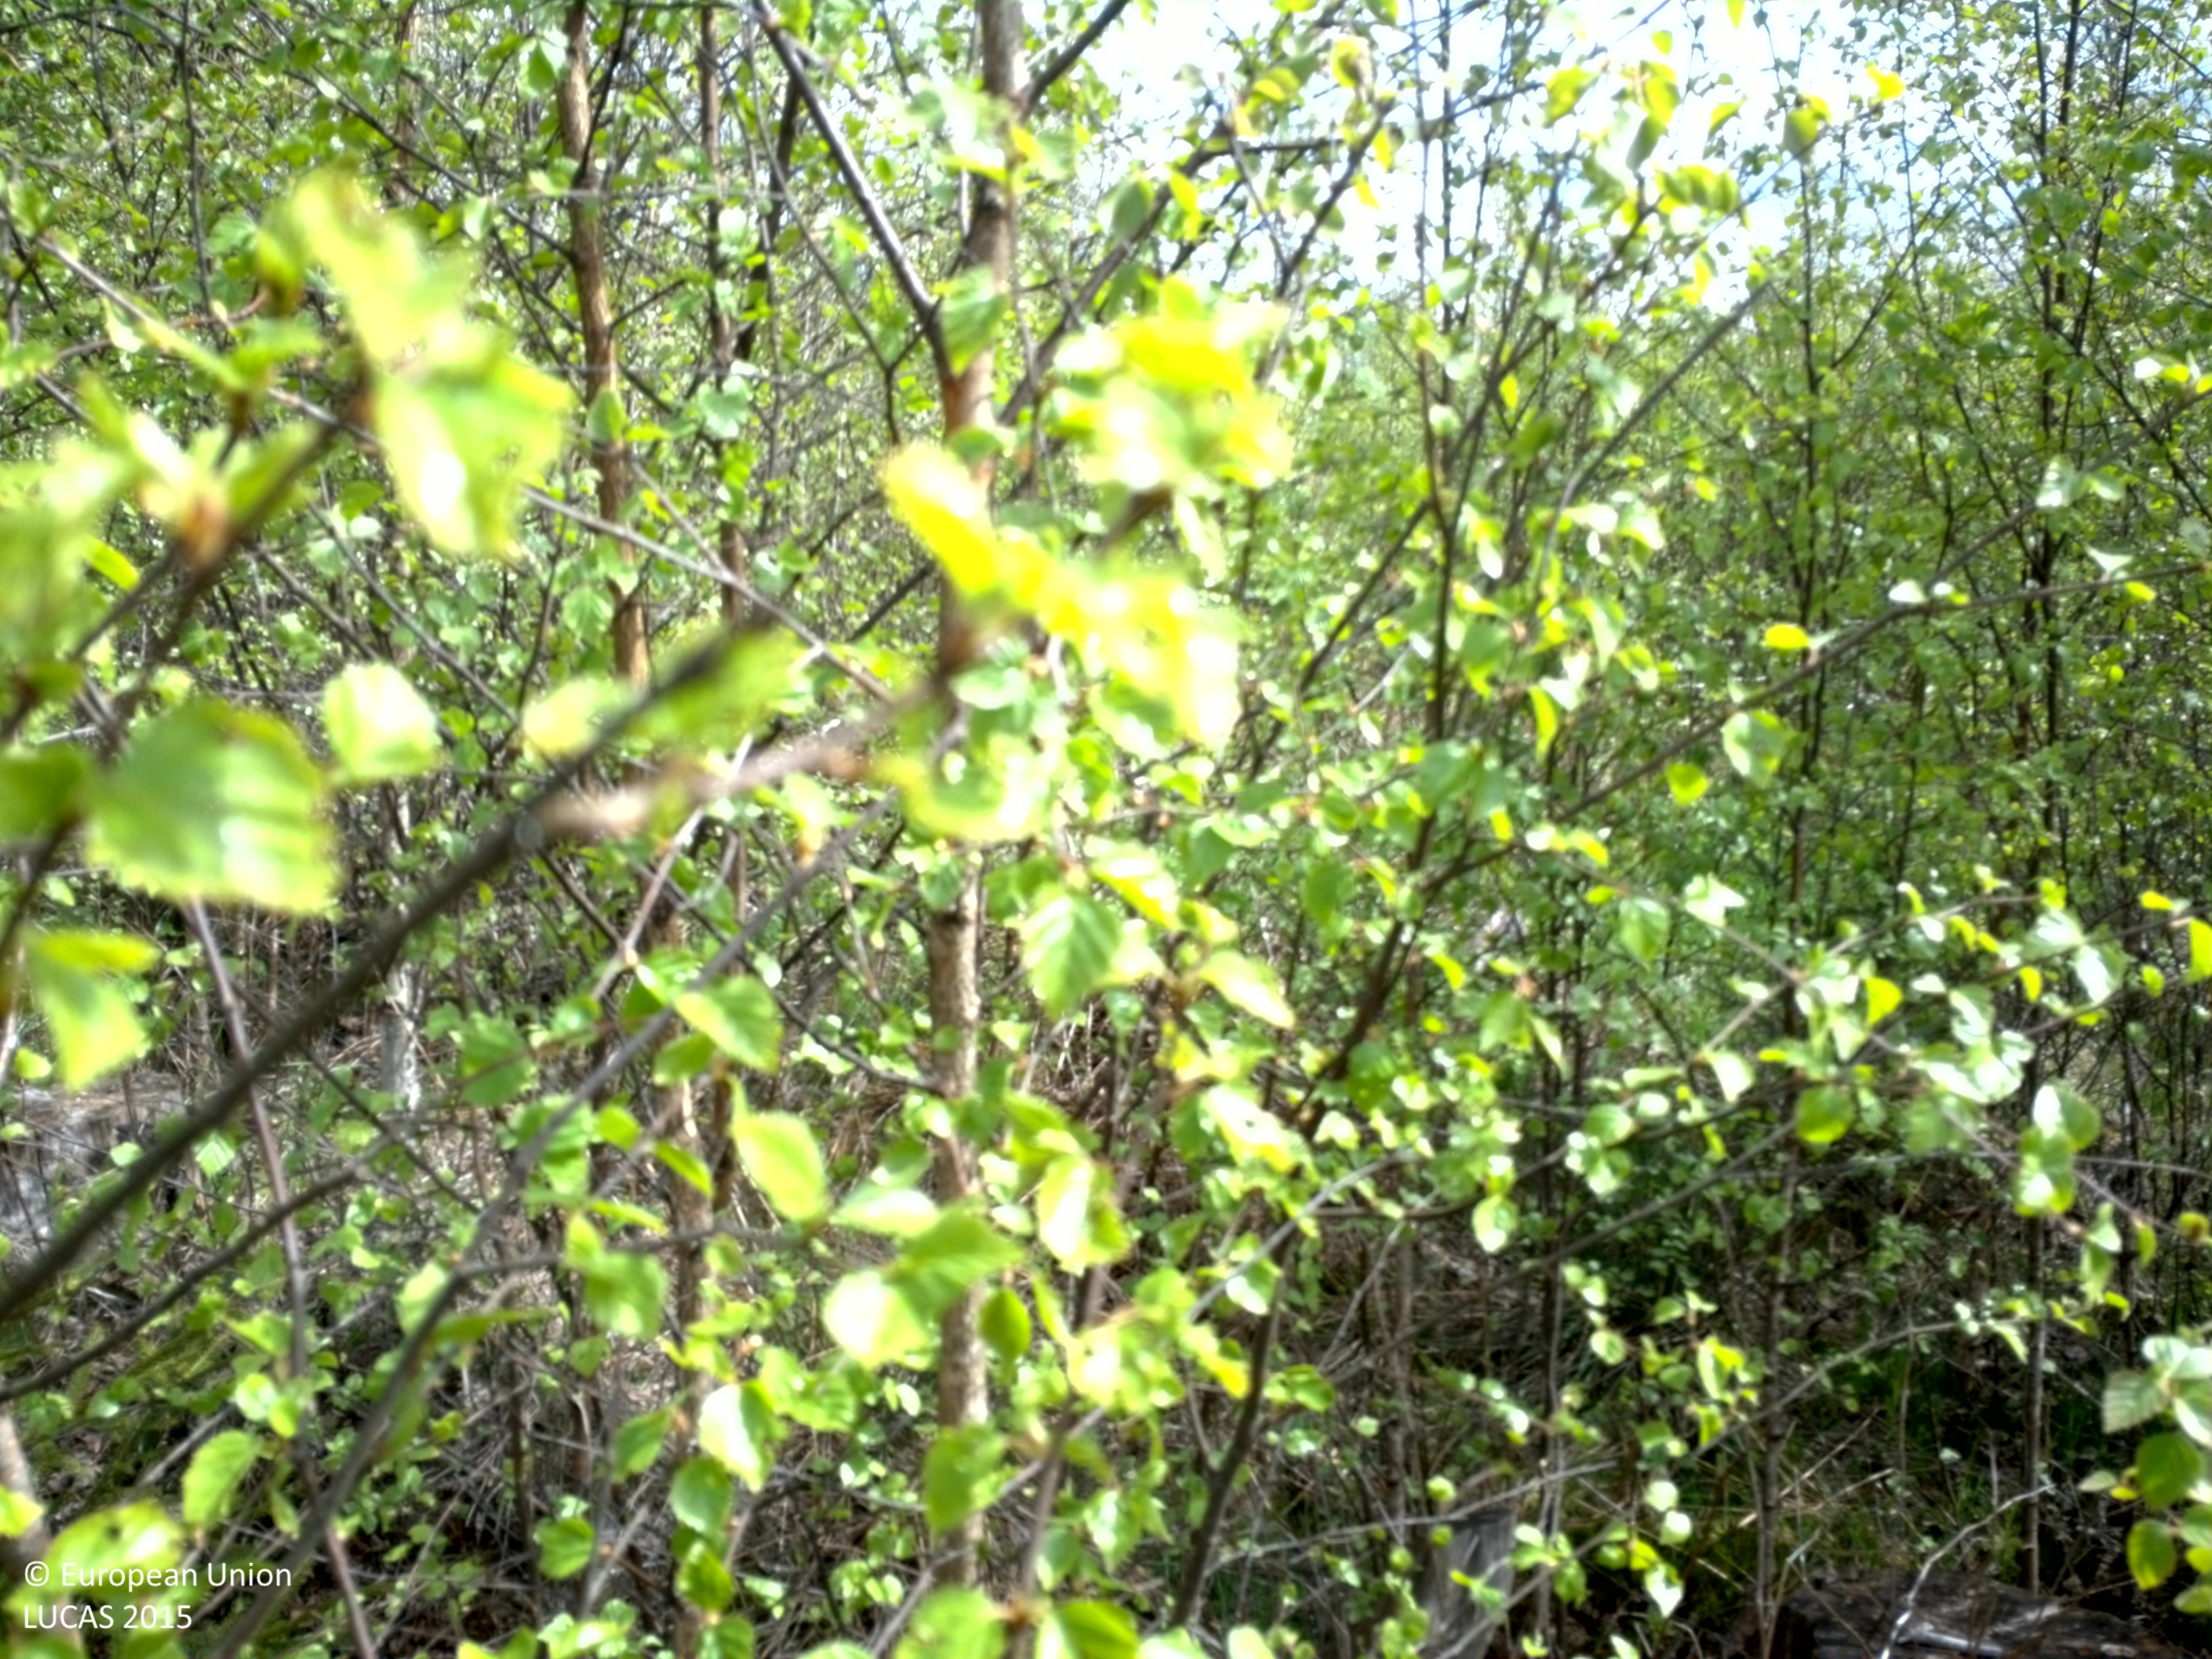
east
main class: Woodland
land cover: Broadleaved woodland
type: boreal forest
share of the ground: > 75 %
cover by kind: broadleaved forest trees 75 %, herbaceous plants 25 %
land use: Forestry
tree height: < 5 m
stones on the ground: < 10 %
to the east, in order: Broadleaved woodland; Ditches and canals; Broadleaved woodland; Spruce dominated coniferous woodland
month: May
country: SE
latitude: 56.7199
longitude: 15.4724
